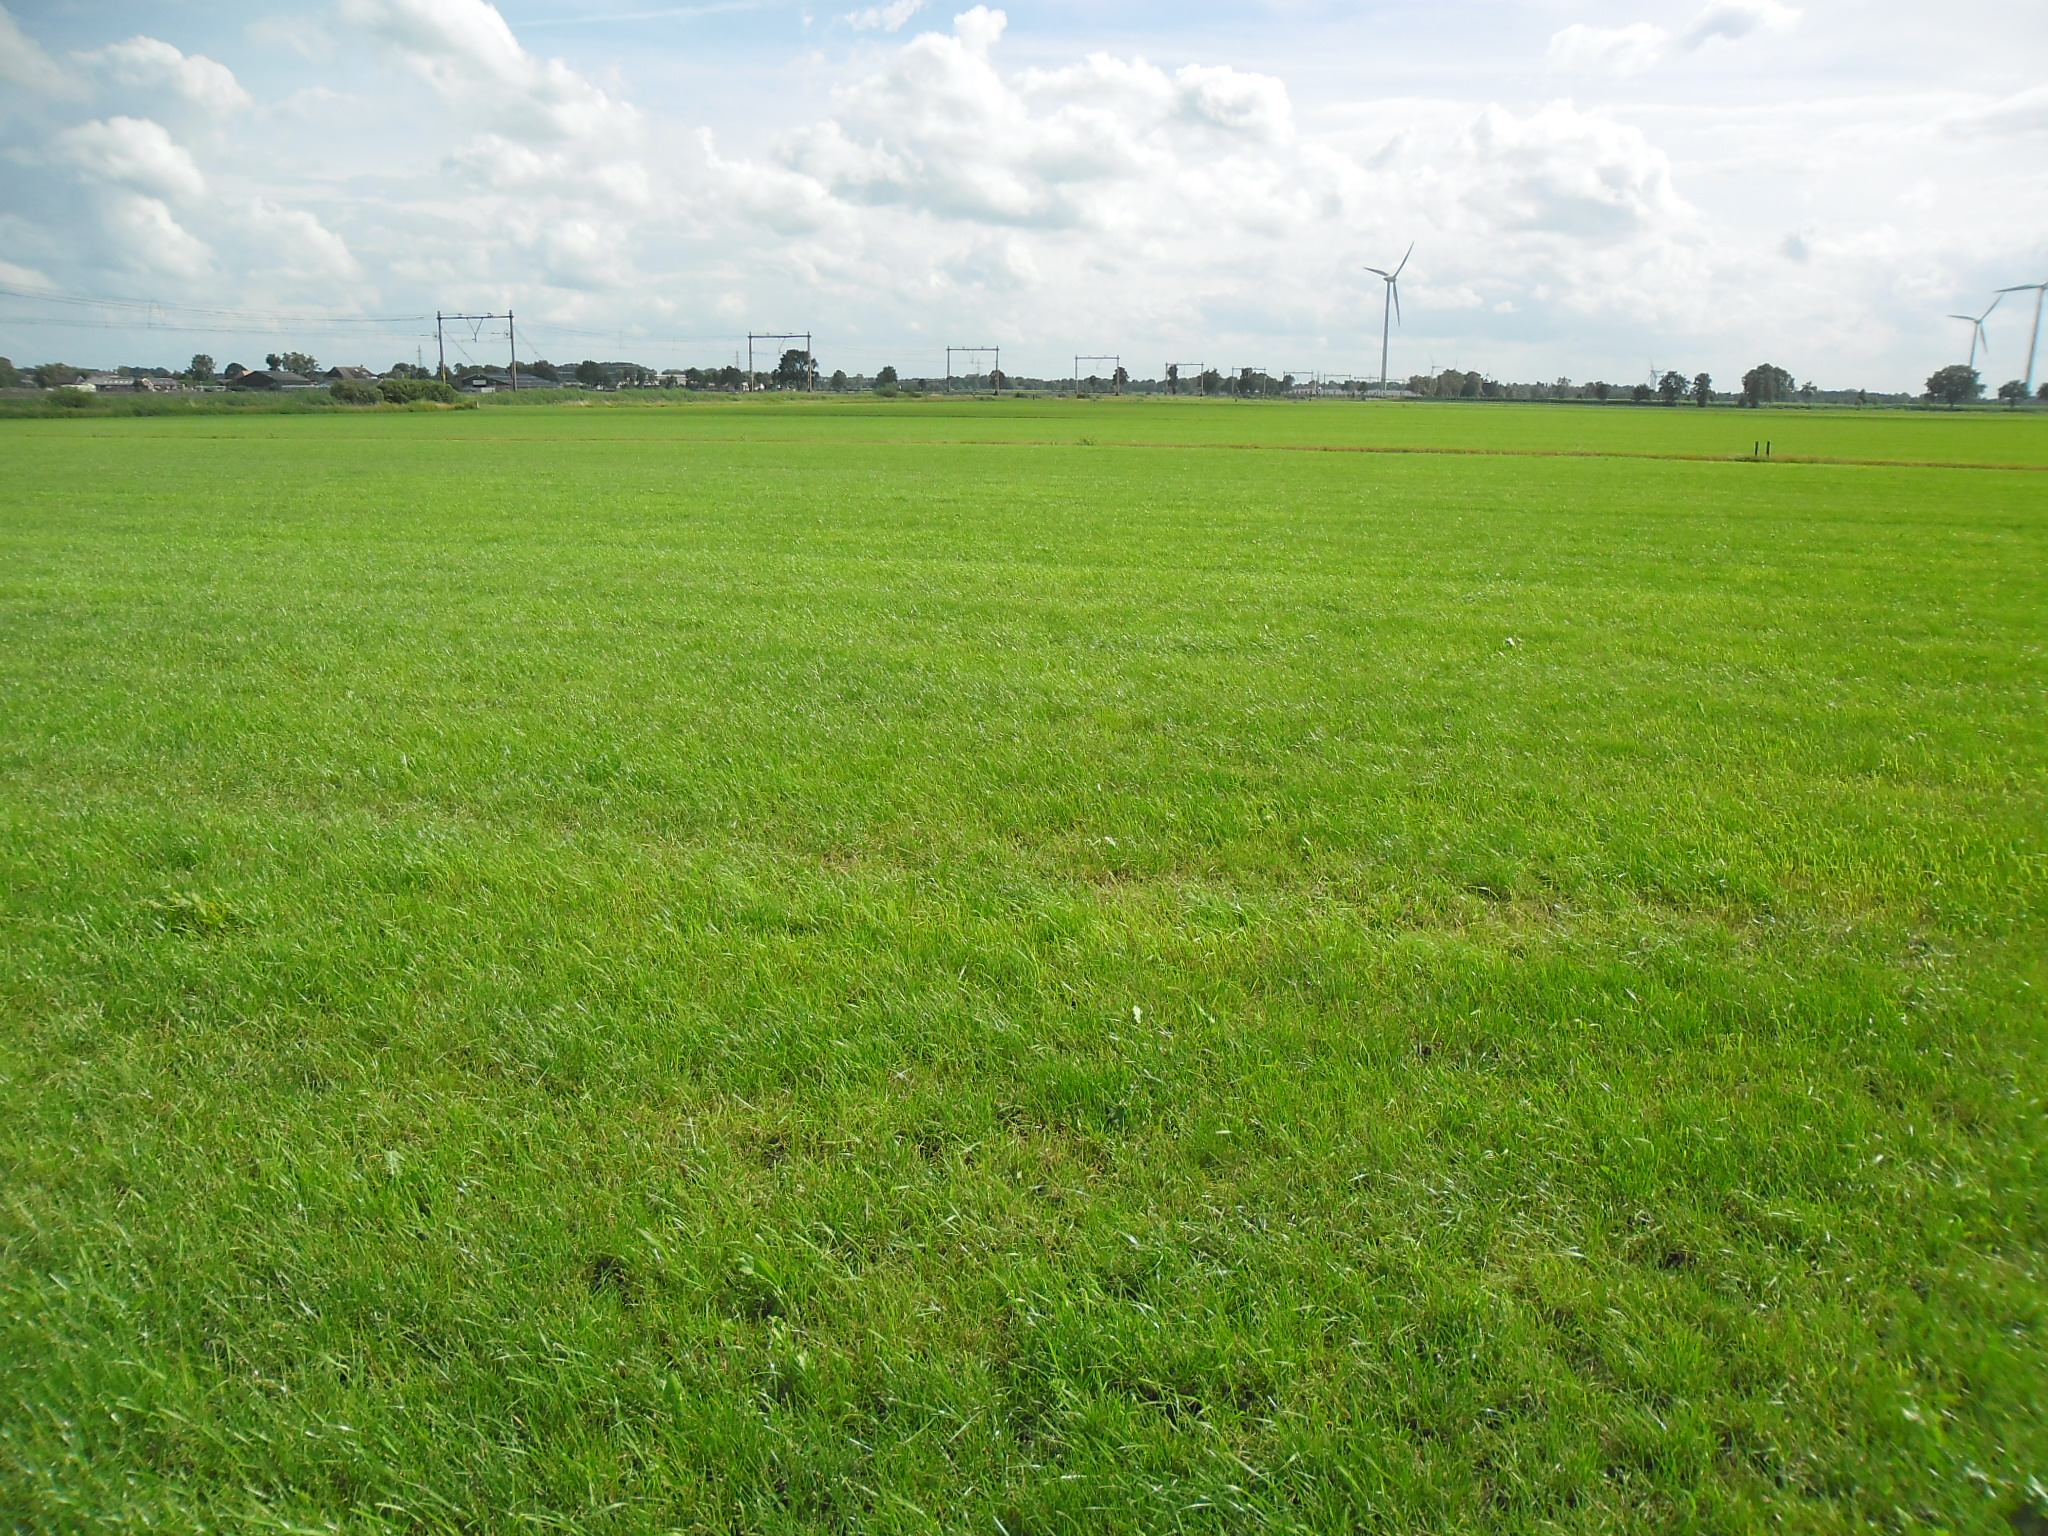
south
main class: Grassland
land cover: Grassland without tree/shrub cover
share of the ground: > 75 %
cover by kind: herbaceous plants 100 %
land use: Agriculture (excluding fallow land and kitchen gardens)
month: July
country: NL
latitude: 52.6057
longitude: 6.2342
